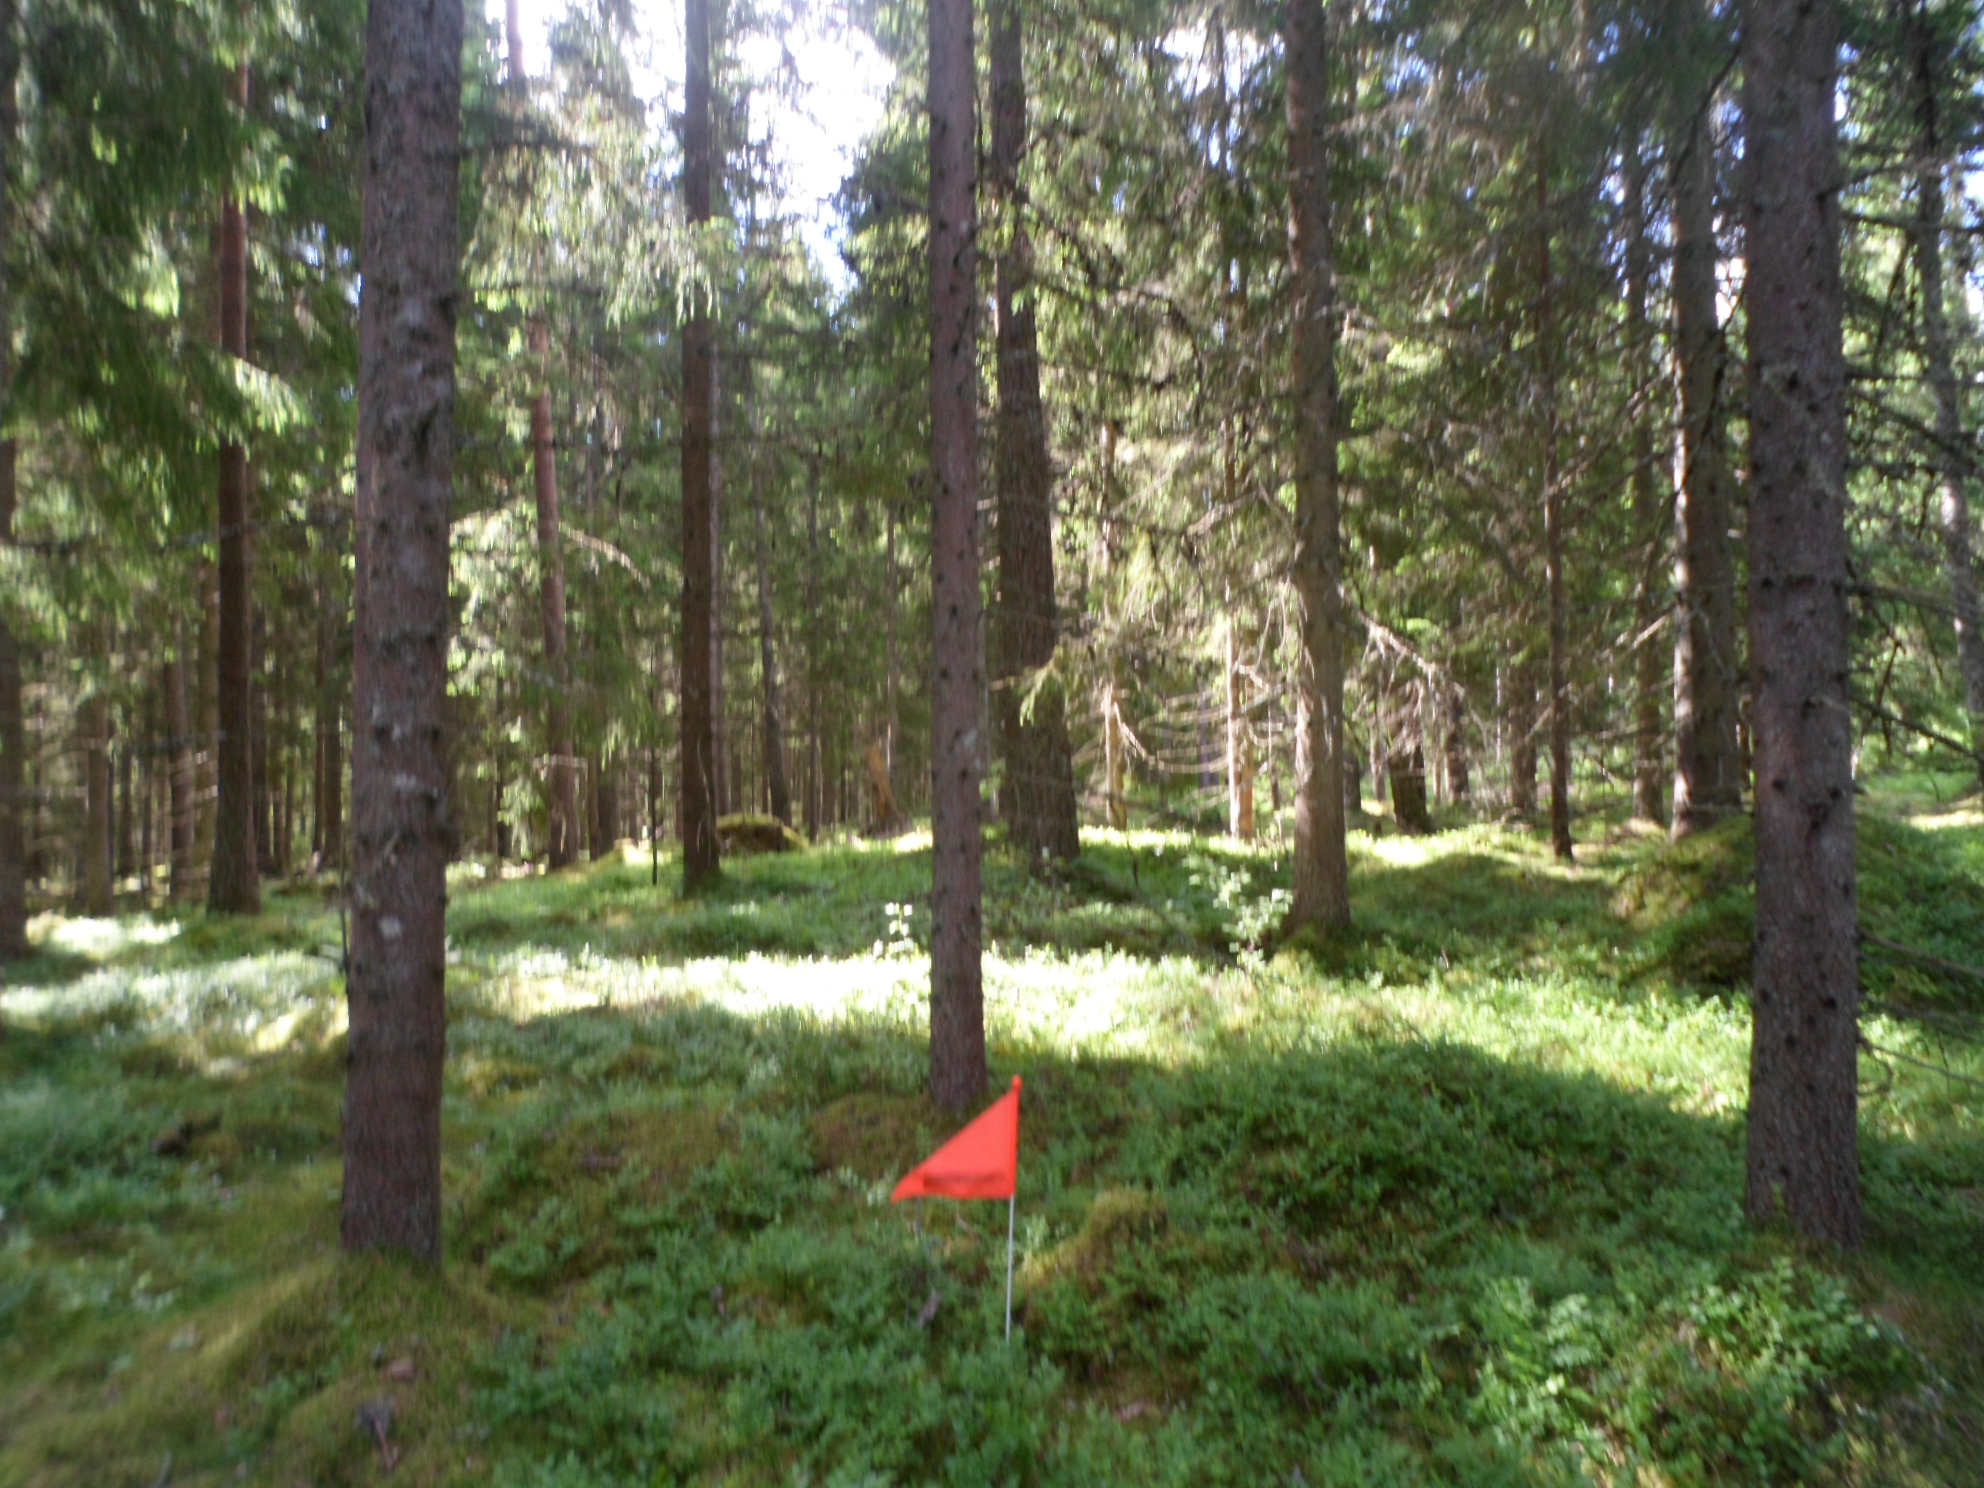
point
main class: Woodland
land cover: Spruce dominated coniferous woodland
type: boreal forest
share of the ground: 50 - 75 %
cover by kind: coniferous forest trees 60 %, lichens and mosses 20 %, shrubs 15 %, herbaceous plants 5 %
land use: Forestry
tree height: > 5 m
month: June
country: SE
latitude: 57.1414
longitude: 14.8386
